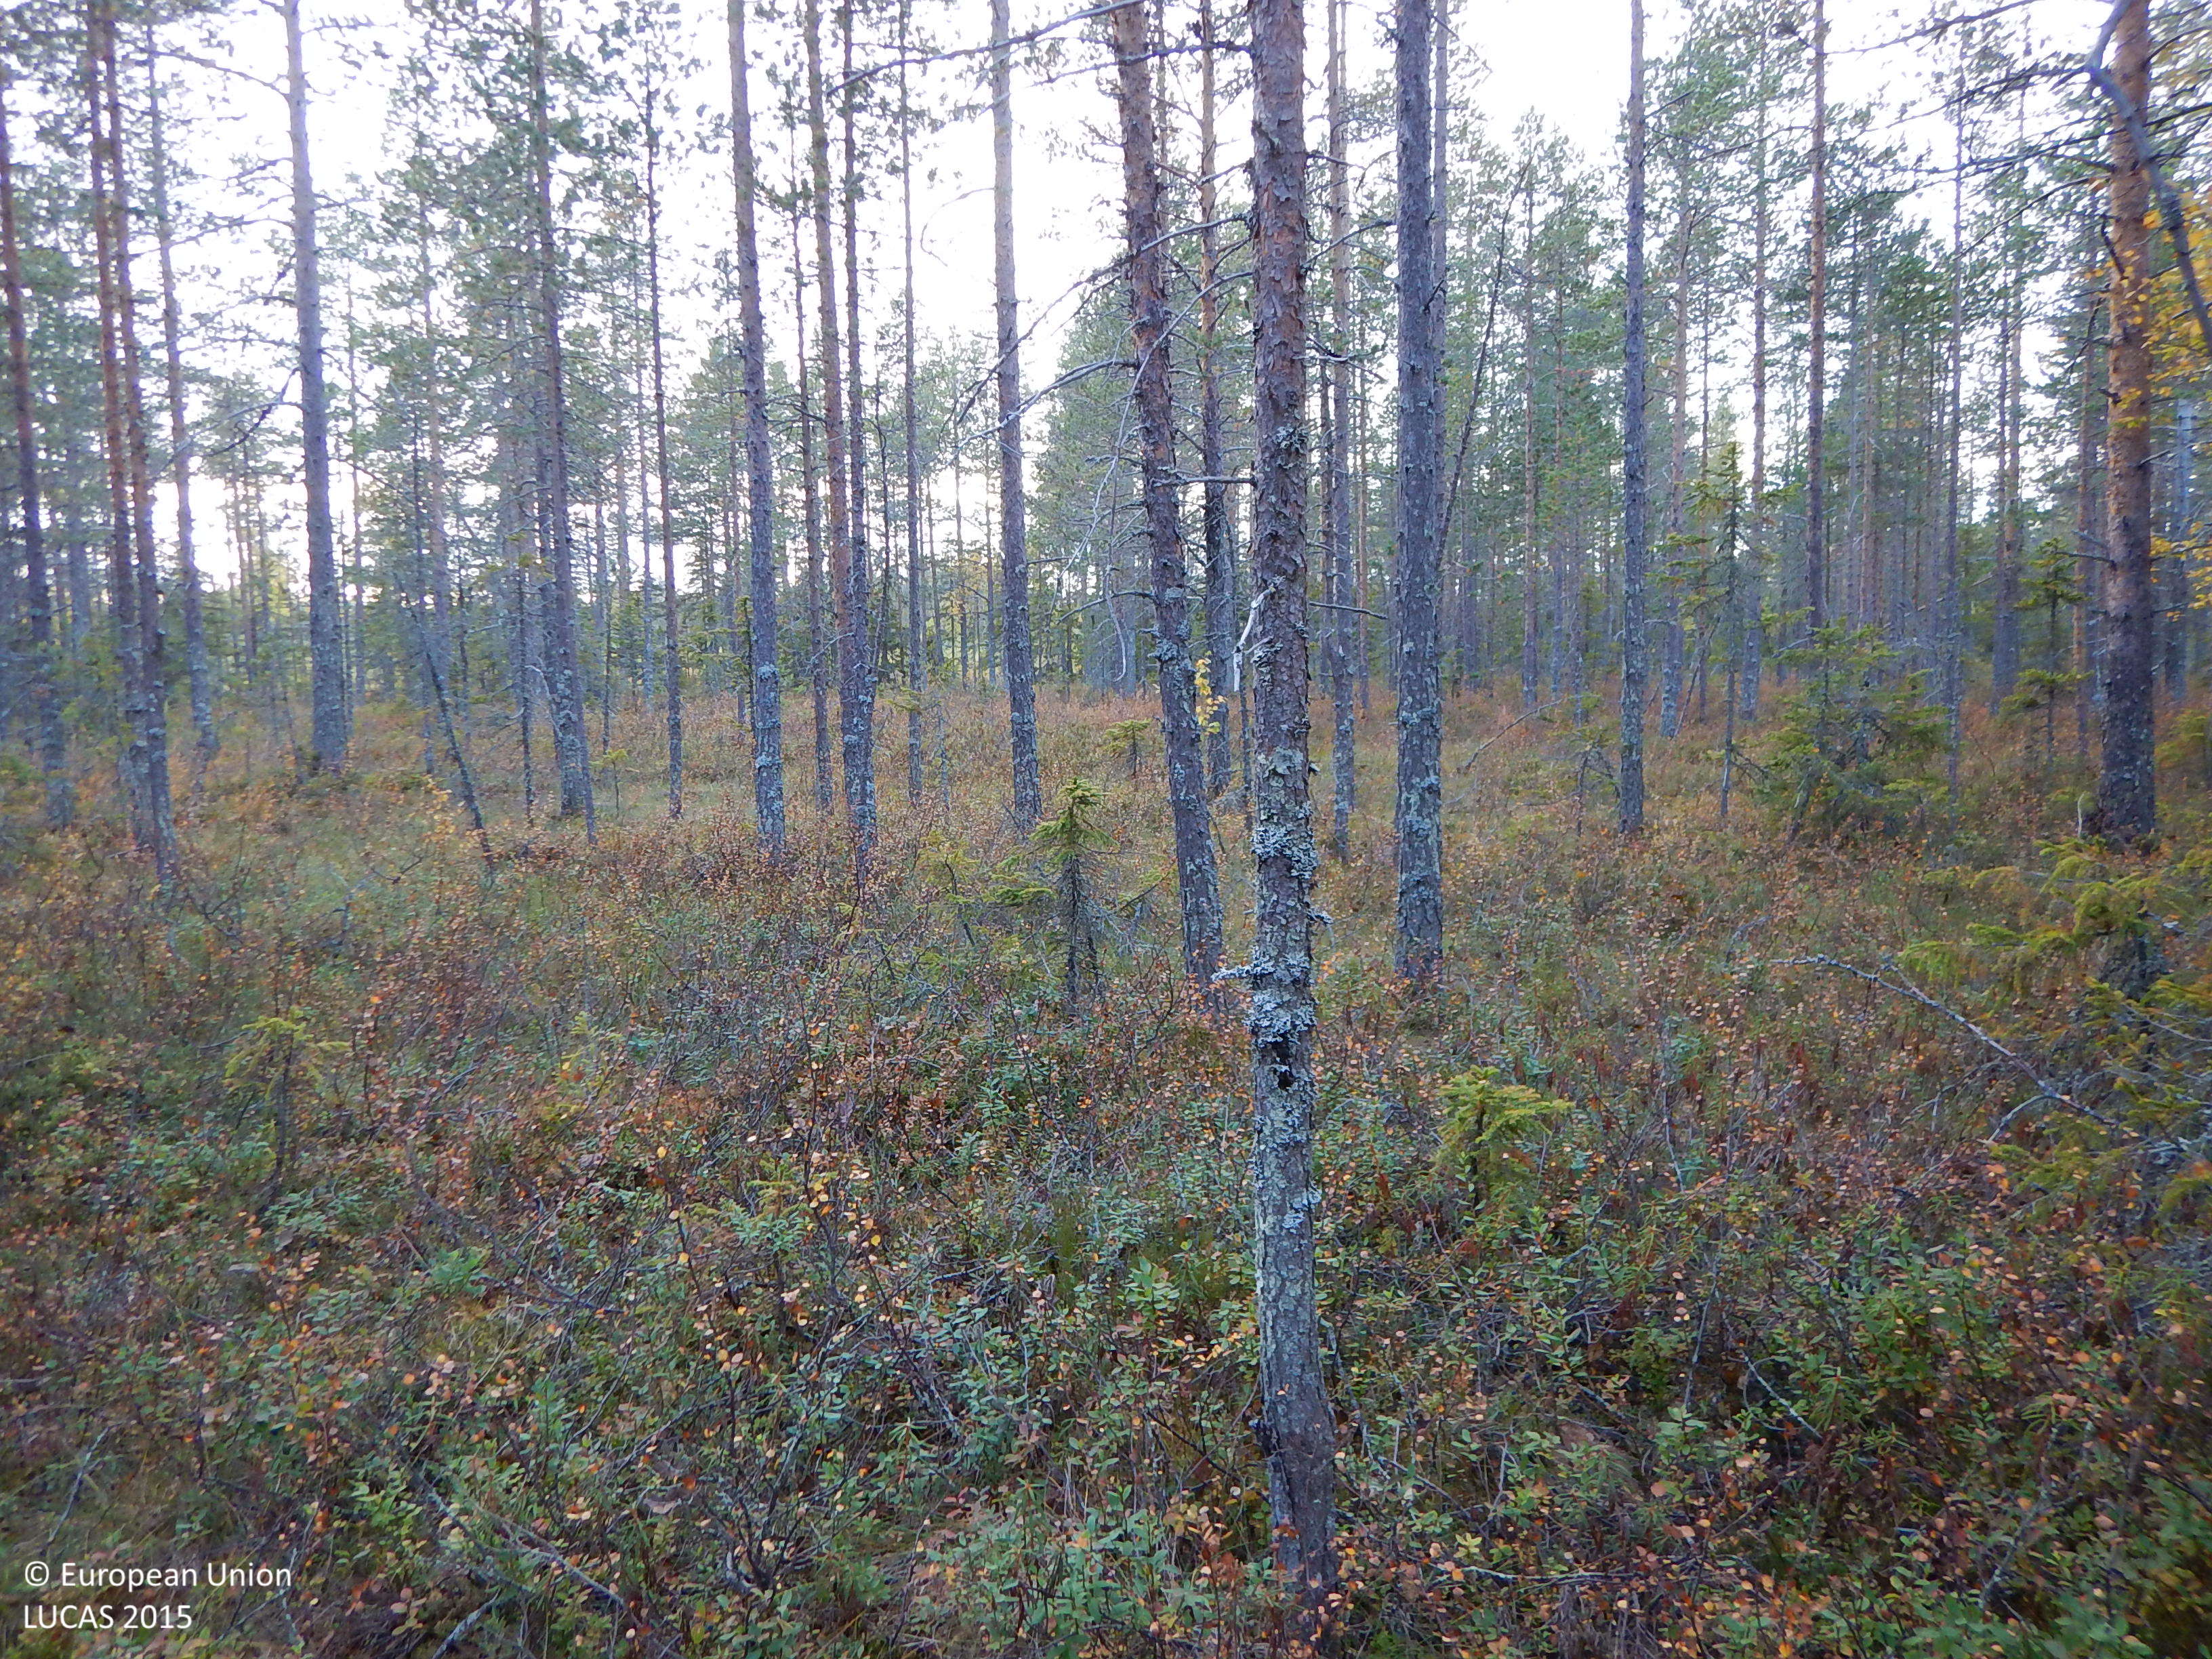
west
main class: Woodland
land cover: Pine dominated coniferous woodland
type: boreal forest
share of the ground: 25 - 50 %
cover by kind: coniferous forest trees 35 %, shrubs 25 %, lichens and mosses 20 %, herbaceous plants 15 %, broadleaved forest trees 5 %
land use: Forestry
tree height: > 5 m
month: September
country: SE
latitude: 64.6750
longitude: 20.1352
